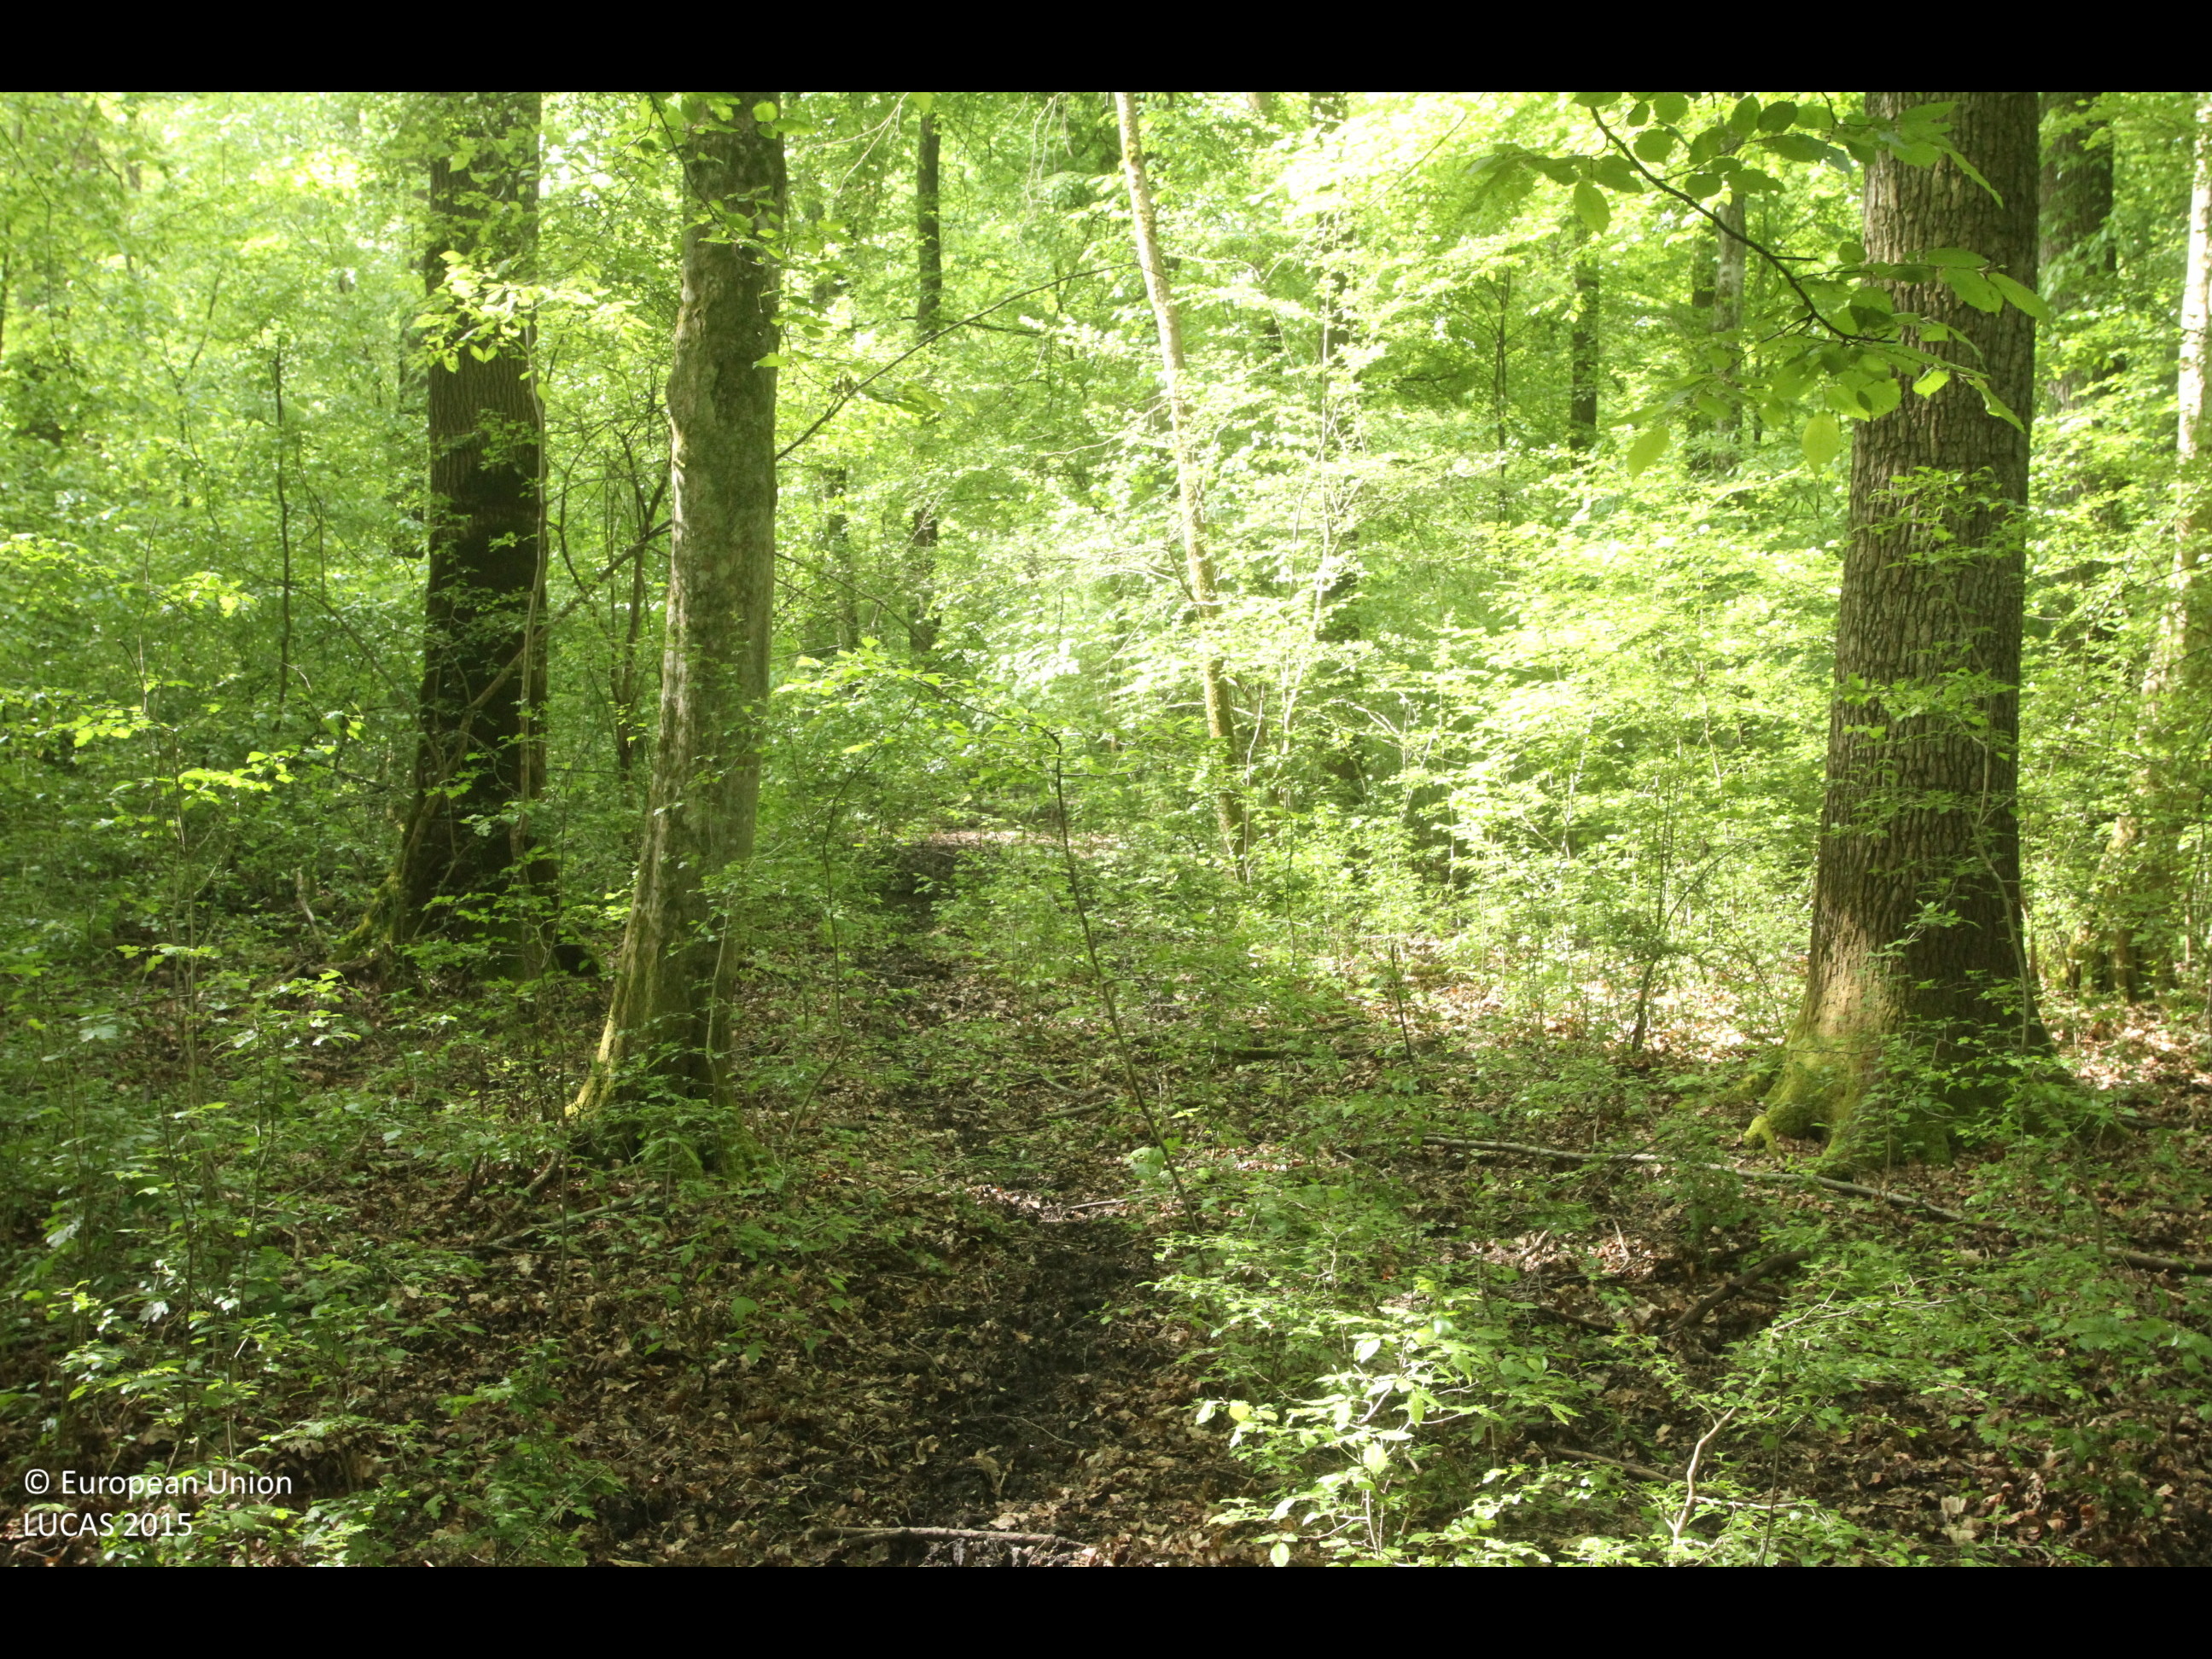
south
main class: Woodland
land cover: Broadleaved woodland
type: mesophytic deciduous forest
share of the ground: > 75 %
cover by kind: broadleaved forest trees 100 %
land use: Forestry
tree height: > 5 m
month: April
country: HR
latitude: 45.0260
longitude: 19.0312
